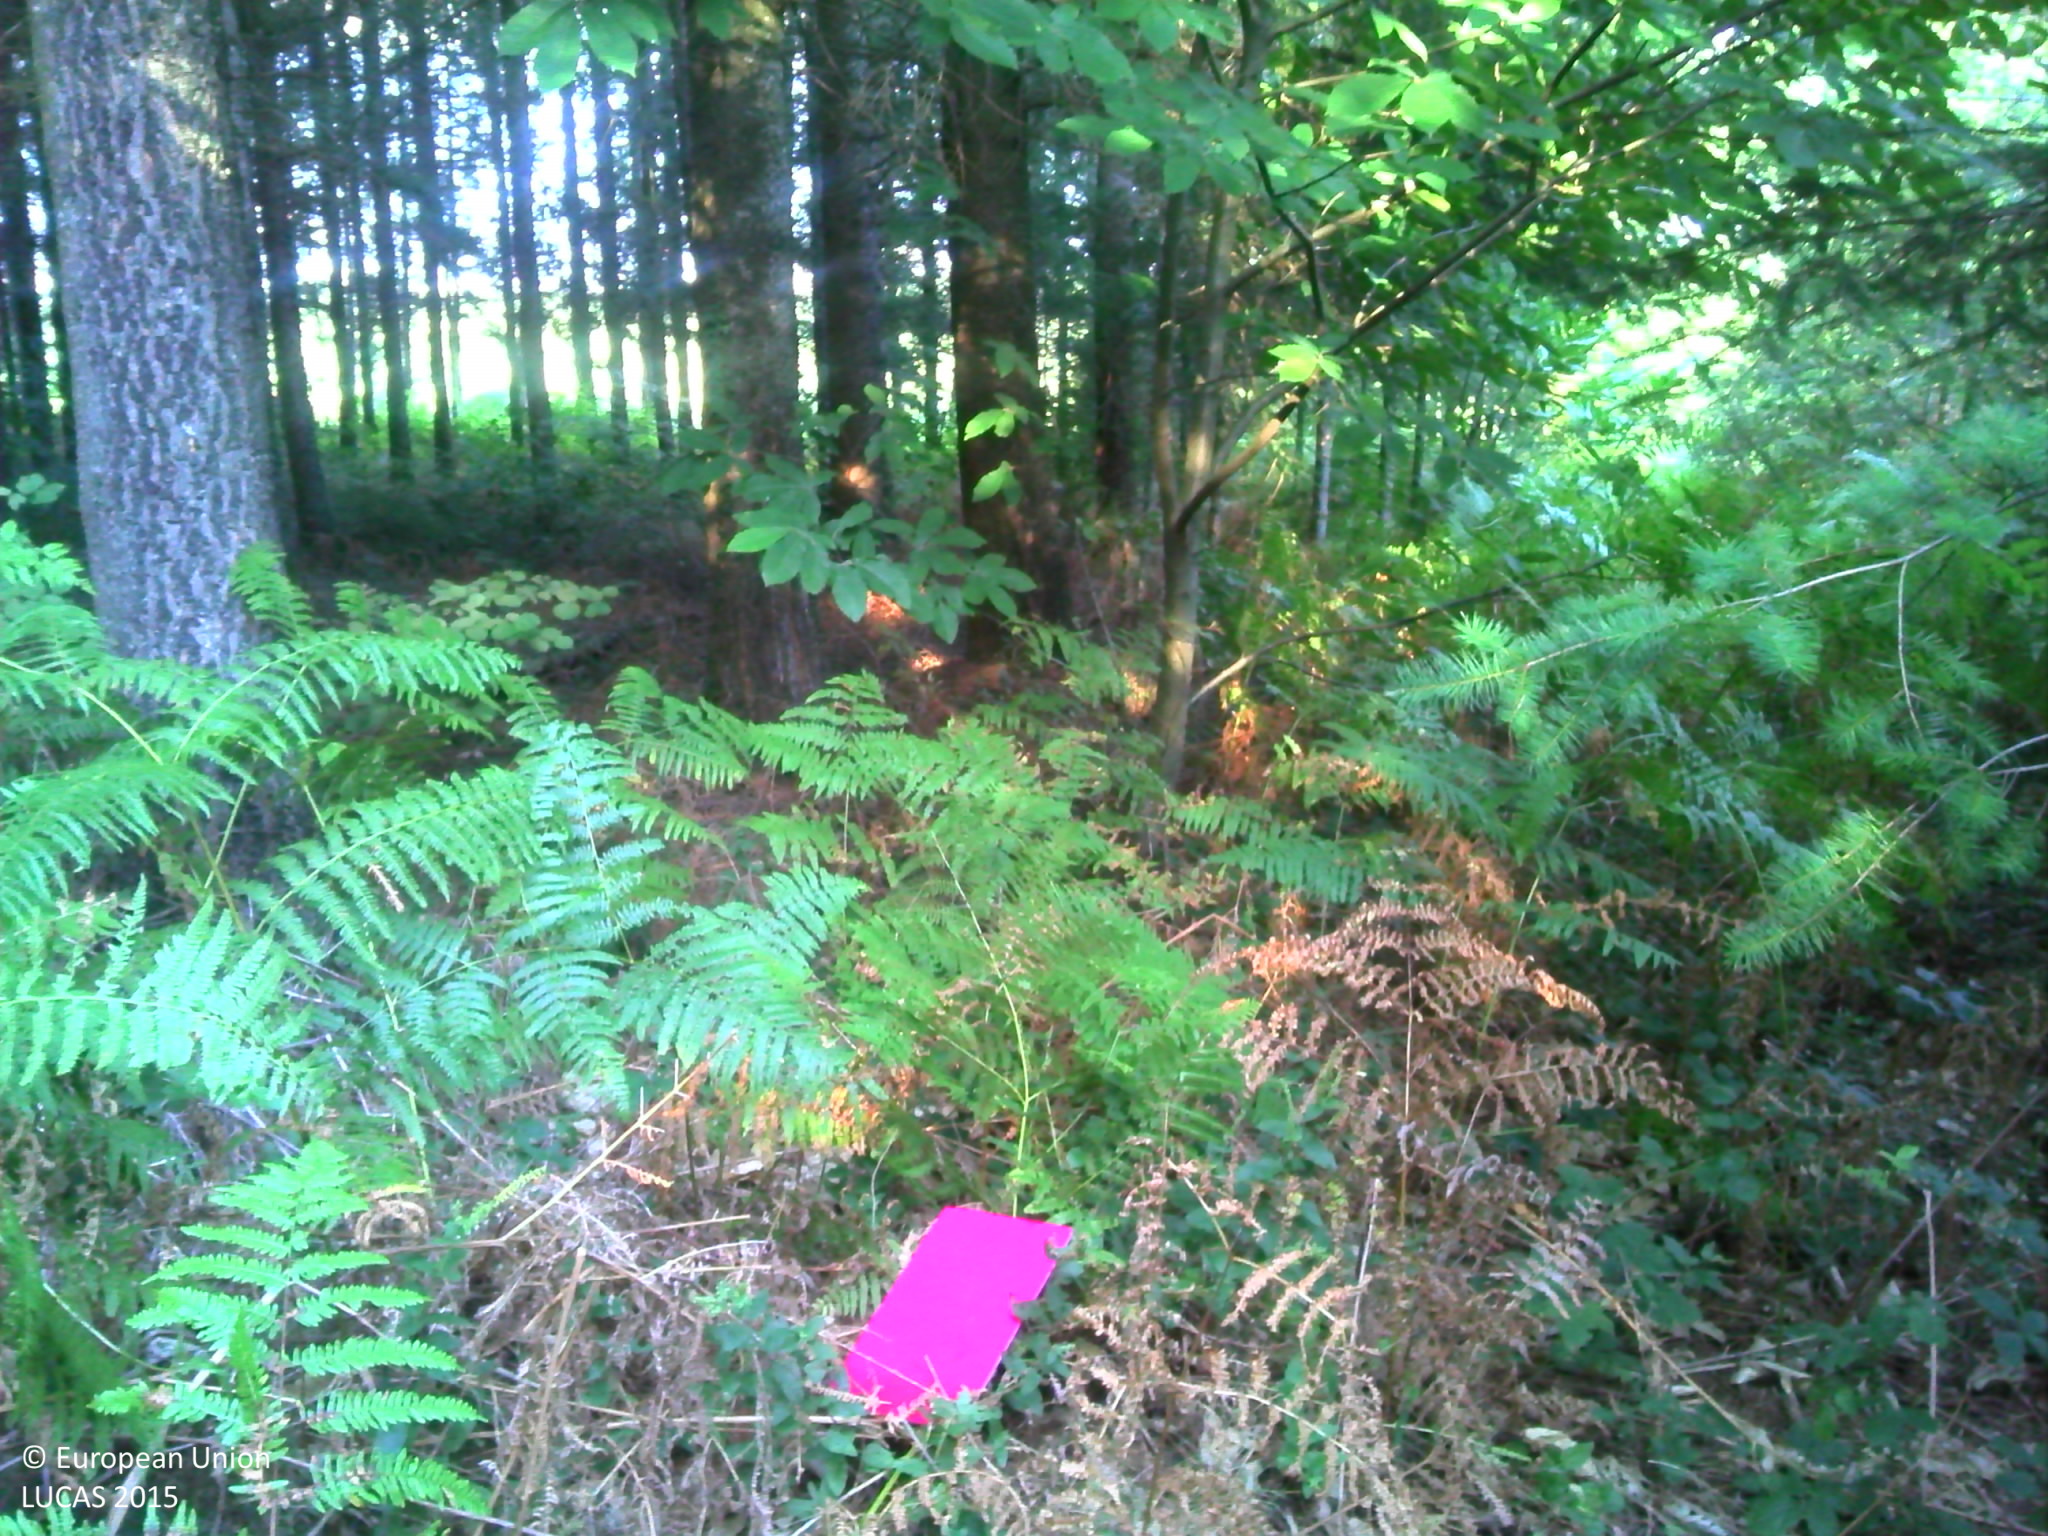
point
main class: Woodland
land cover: Other coniferous woodland
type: exotic forest
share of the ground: > 75 %
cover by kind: coniferous forest trees 70 %, herbaceous plants 15 %, broadleaved forest trees 5 %, shrubs 5 %, lichens and mosses 5 %
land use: Forestry
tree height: > 5 m
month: August
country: FR
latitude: 45.8860
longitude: 1.7335
